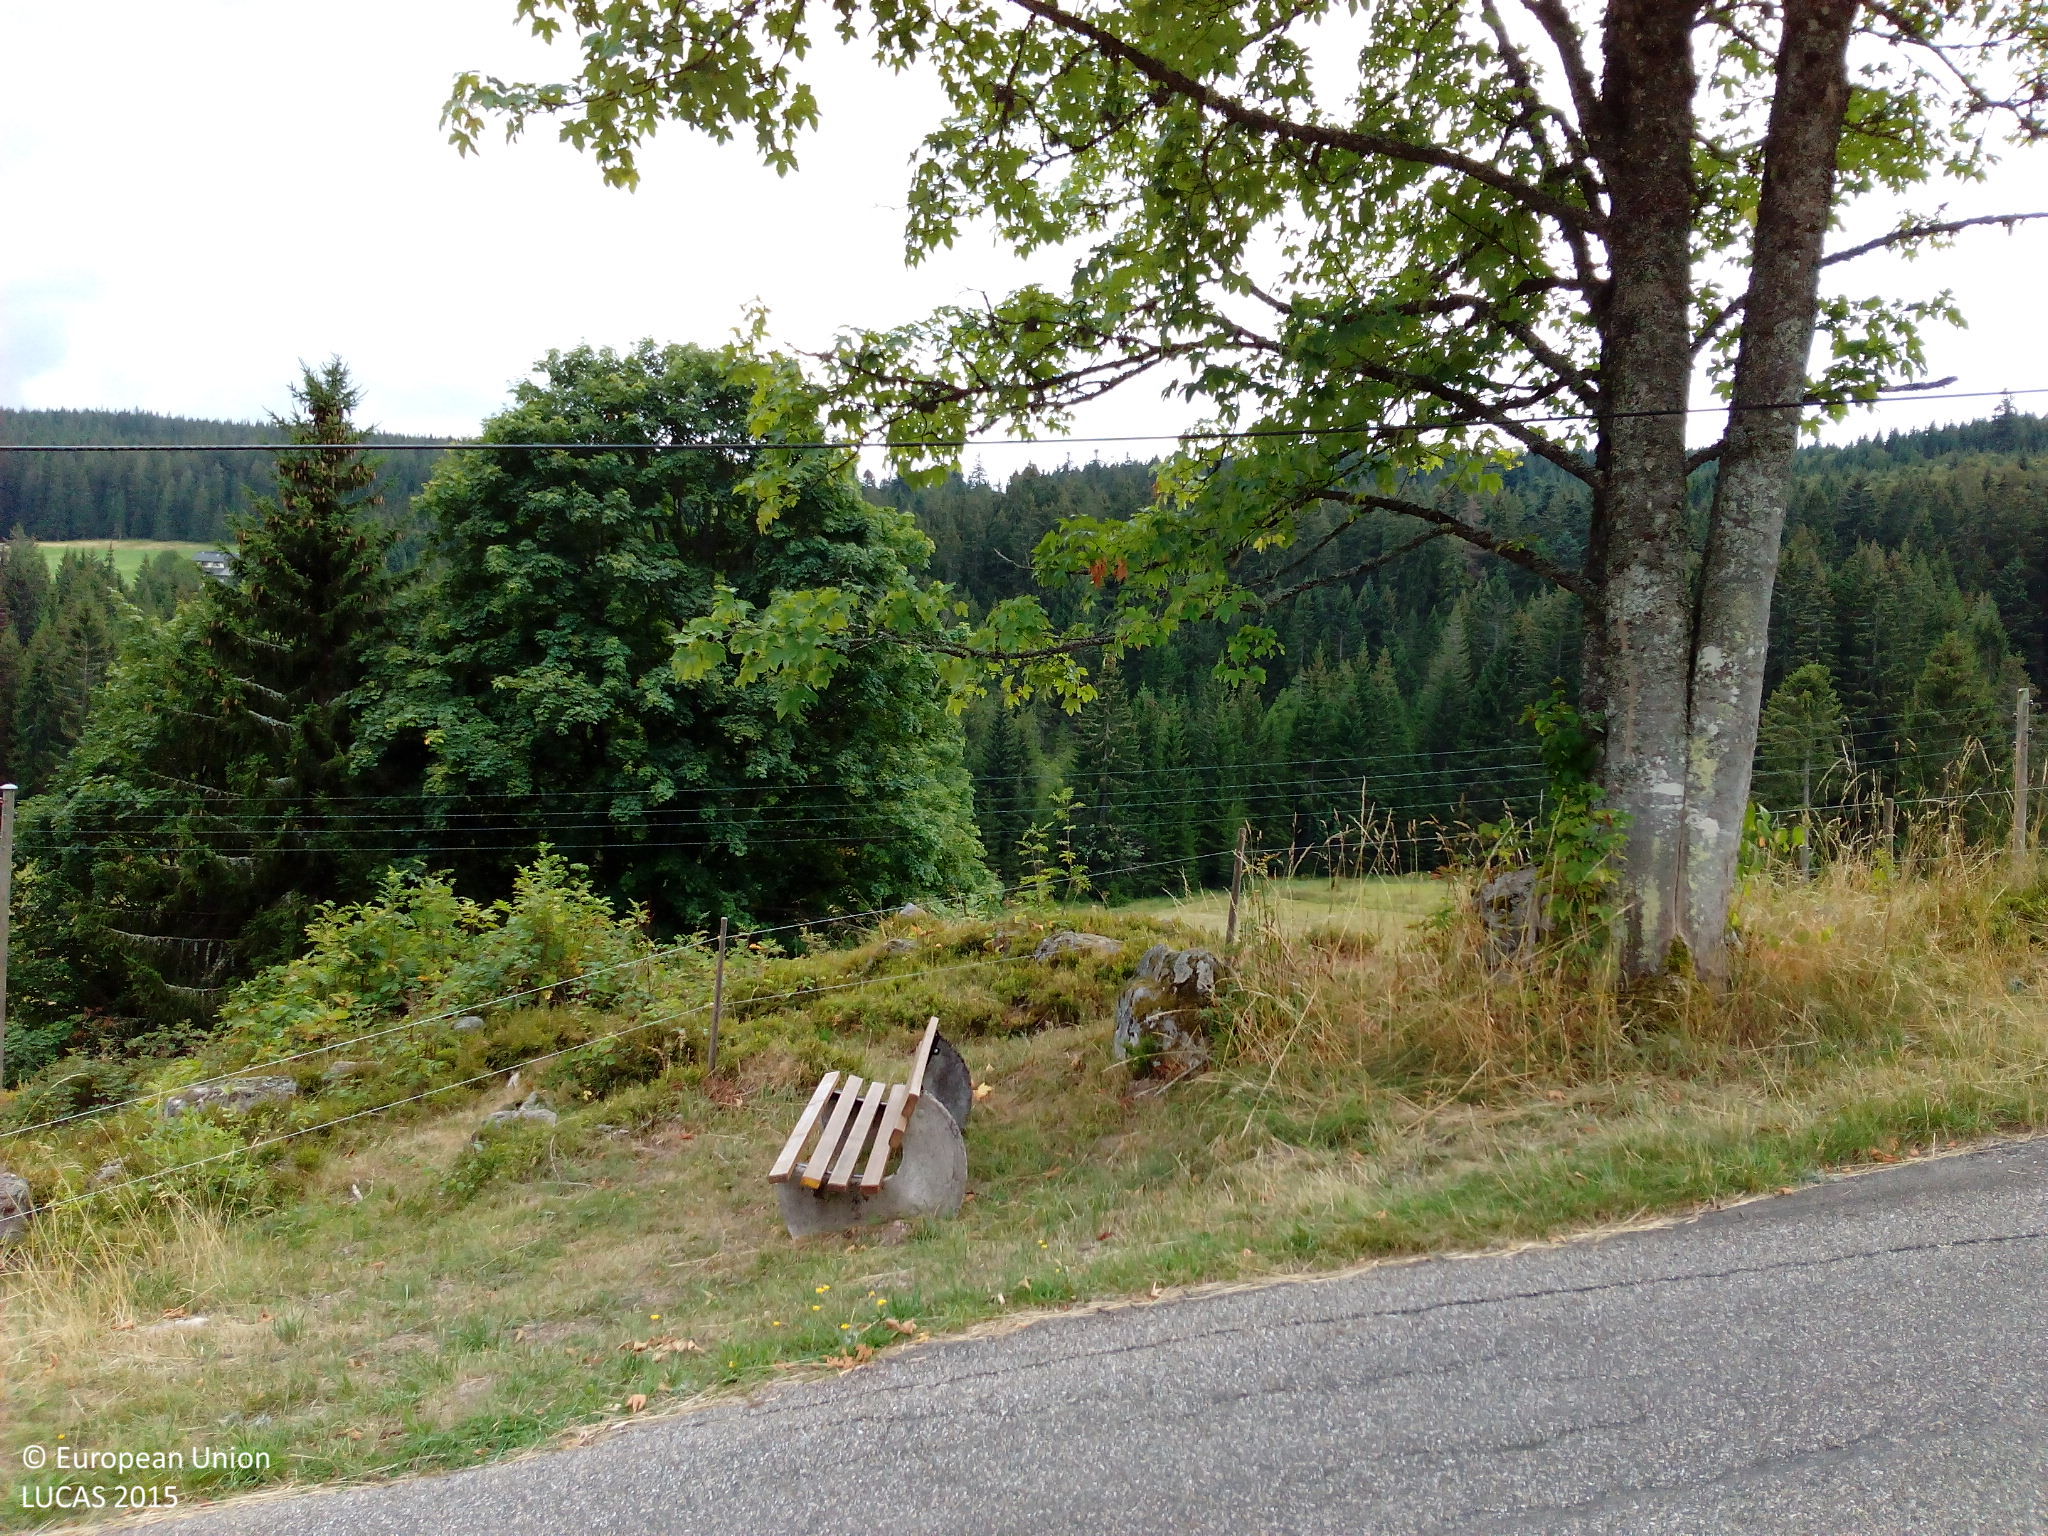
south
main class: Shrubland
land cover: Shrubland without tree cover
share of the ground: 25 - 50 %
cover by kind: herbaceous plants 75 %, shrubs 25 %
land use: Agriculture (excluding fallow land and kitchen gardens)
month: August
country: DE
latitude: 47.7939
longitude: 8.1456
